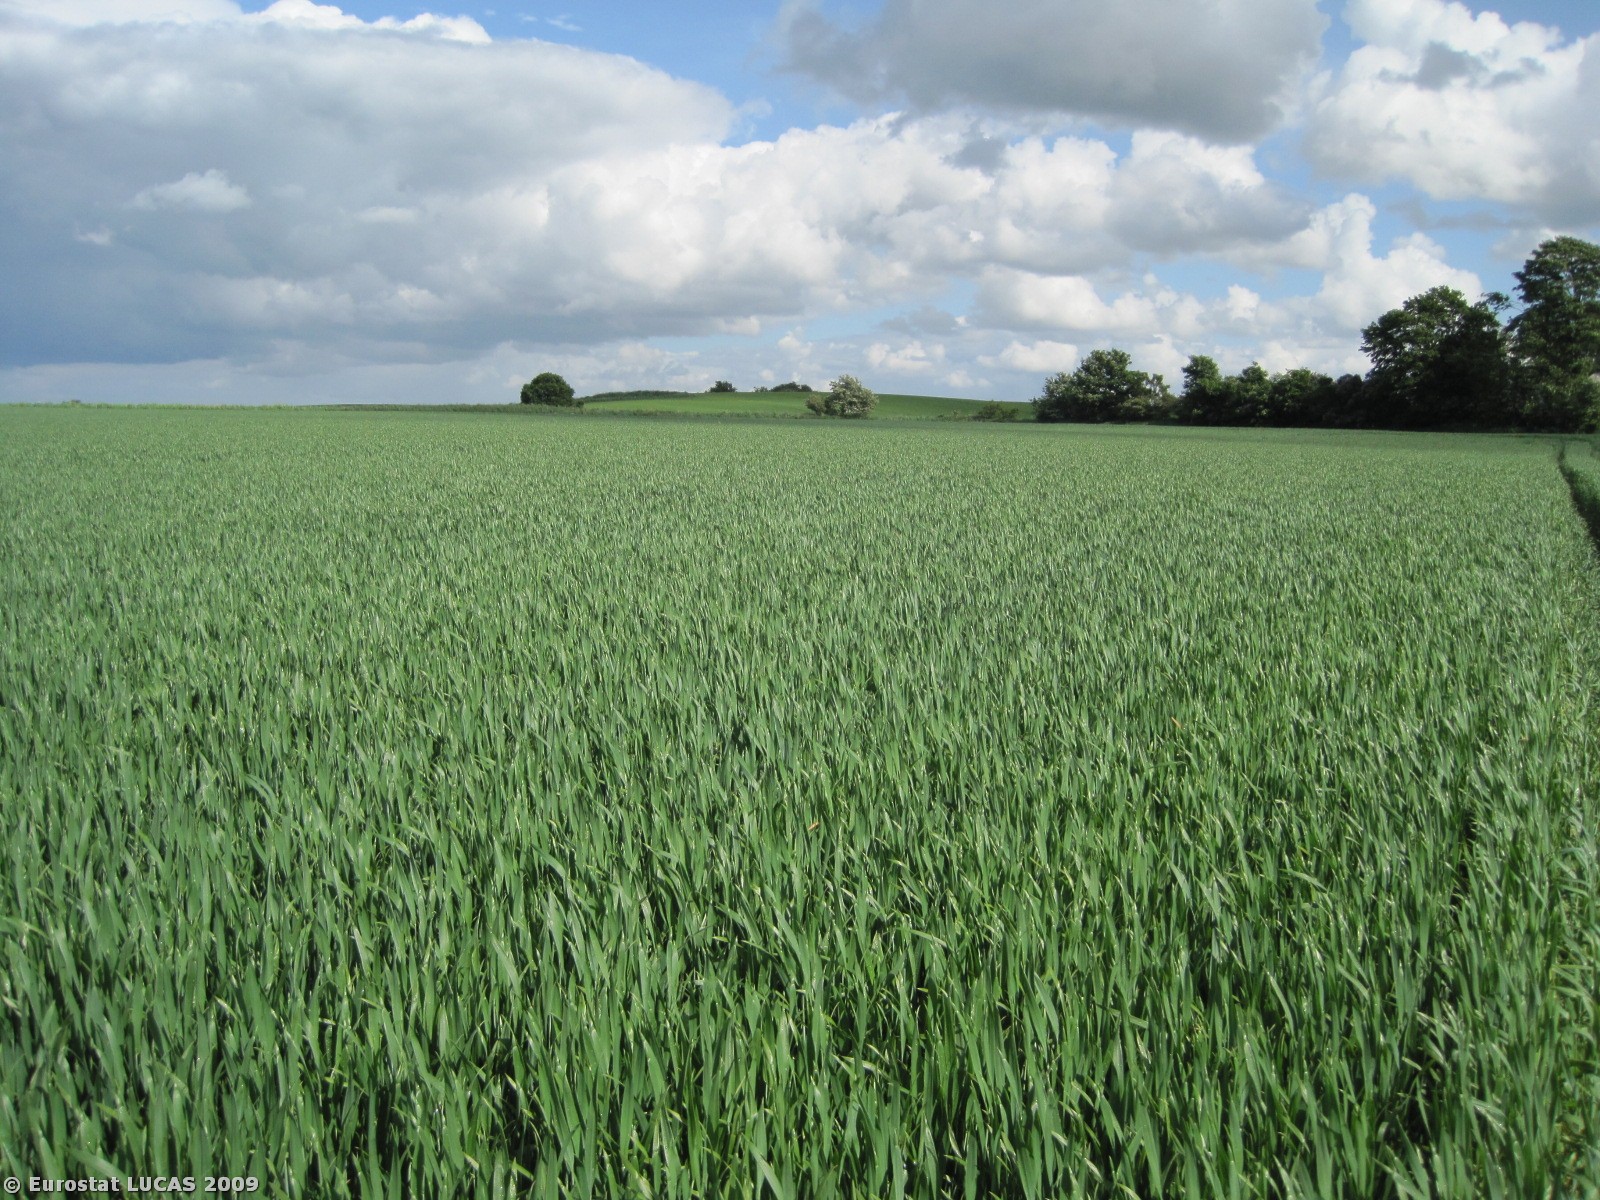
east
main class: Cropland
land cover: Common wheat
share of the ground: > 75 %
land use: Agriculture (excluding fallow land and kitchen gardens)
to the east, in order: Common wheat; Grass margins; Common wheat; Grass margins; Ditches and canals; Grass margins; Barley
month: May
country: DK
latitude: 56.5113
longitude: 9.9838
